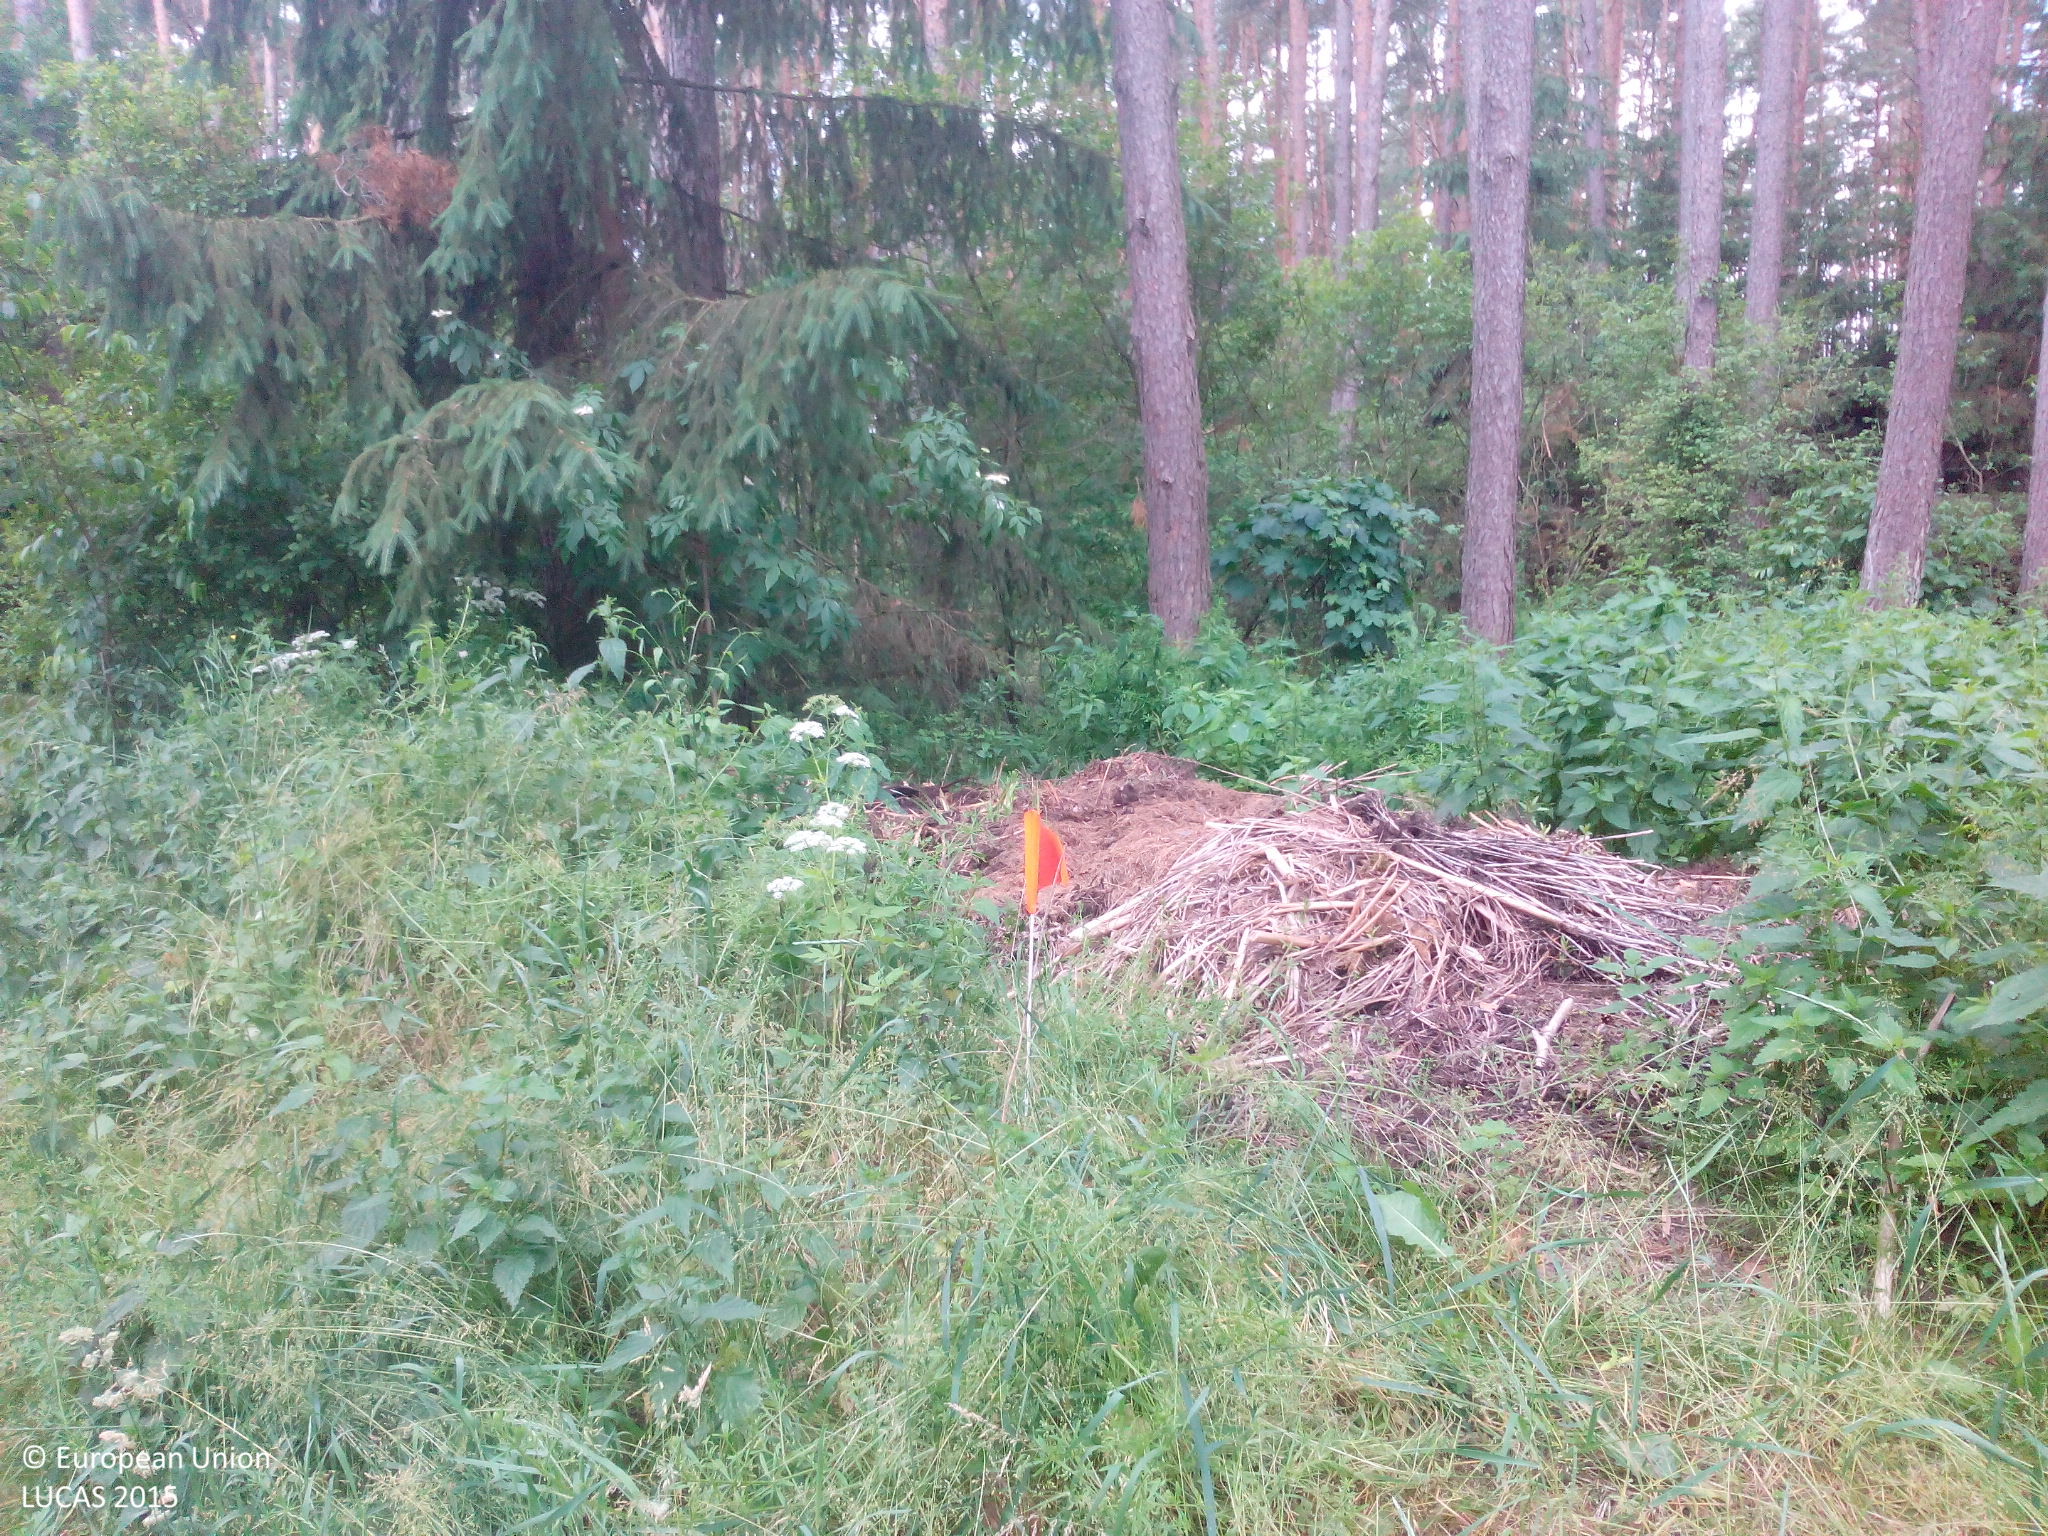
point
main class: Woodland
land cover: Pine dominated coniferous woodland
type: hemiboreal forest and nemoral coniferous forest and mixed broadleaved-coniferous forest
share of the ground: 50 - 75 %
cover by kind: coniferous forest trees 70 %, herbaceous plants 20 %, shrubs 10 %
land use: Forestry
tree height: > 5 m
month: June
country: DE
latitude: 49.2093
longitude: 10.9193
